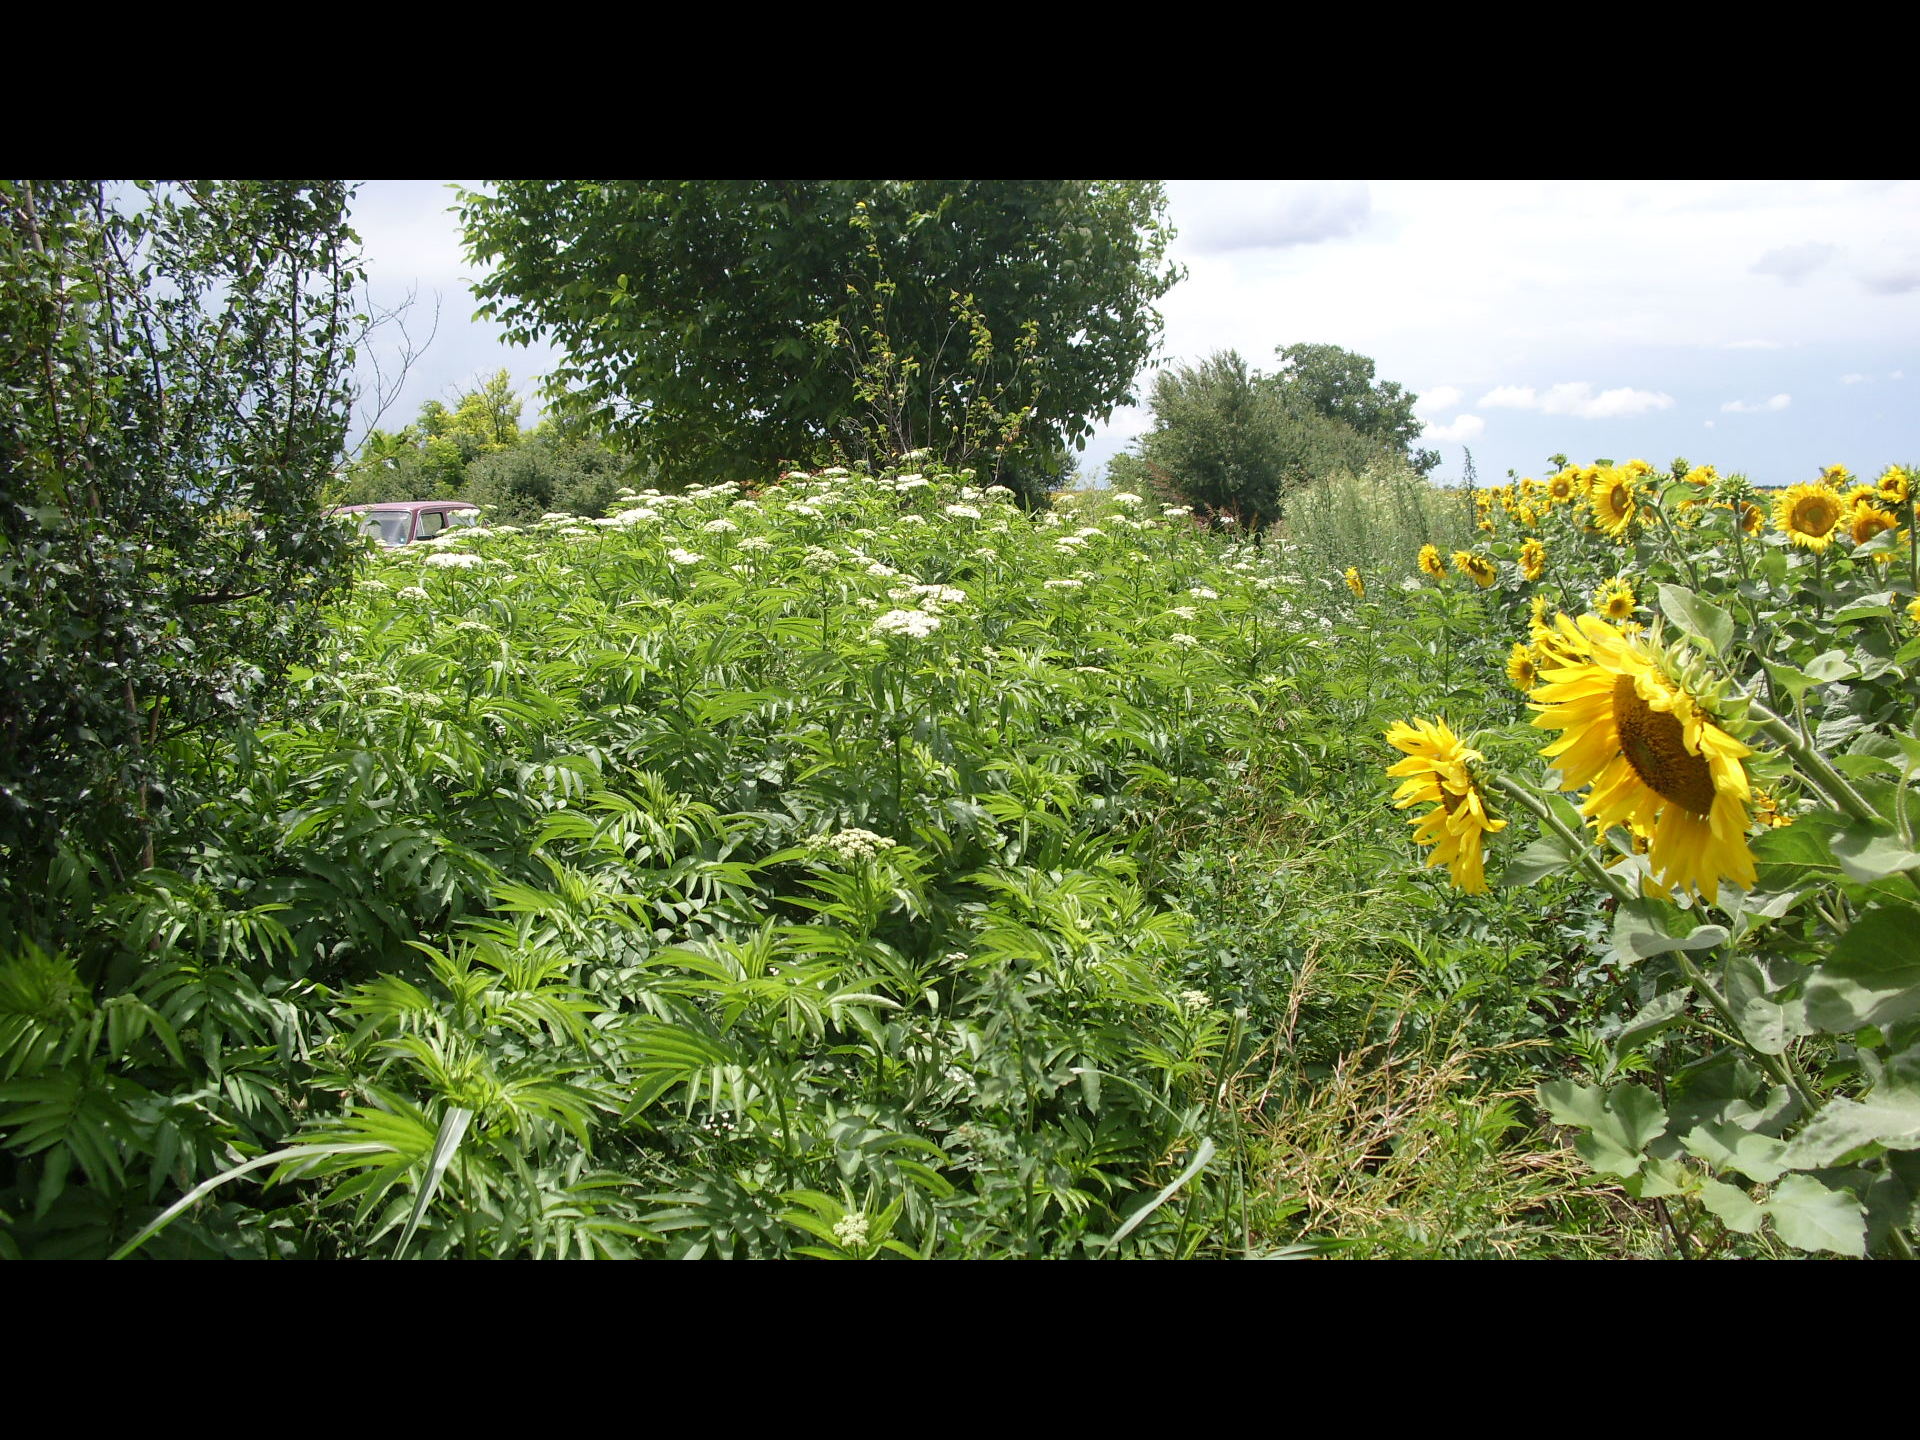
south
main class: Cropland
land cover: Sunflower
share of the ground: > 75 %
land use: Agriculture (excluding fallow land and kitchen gardens)
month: June
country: BG
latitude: 43.6226
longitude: 23.5419
